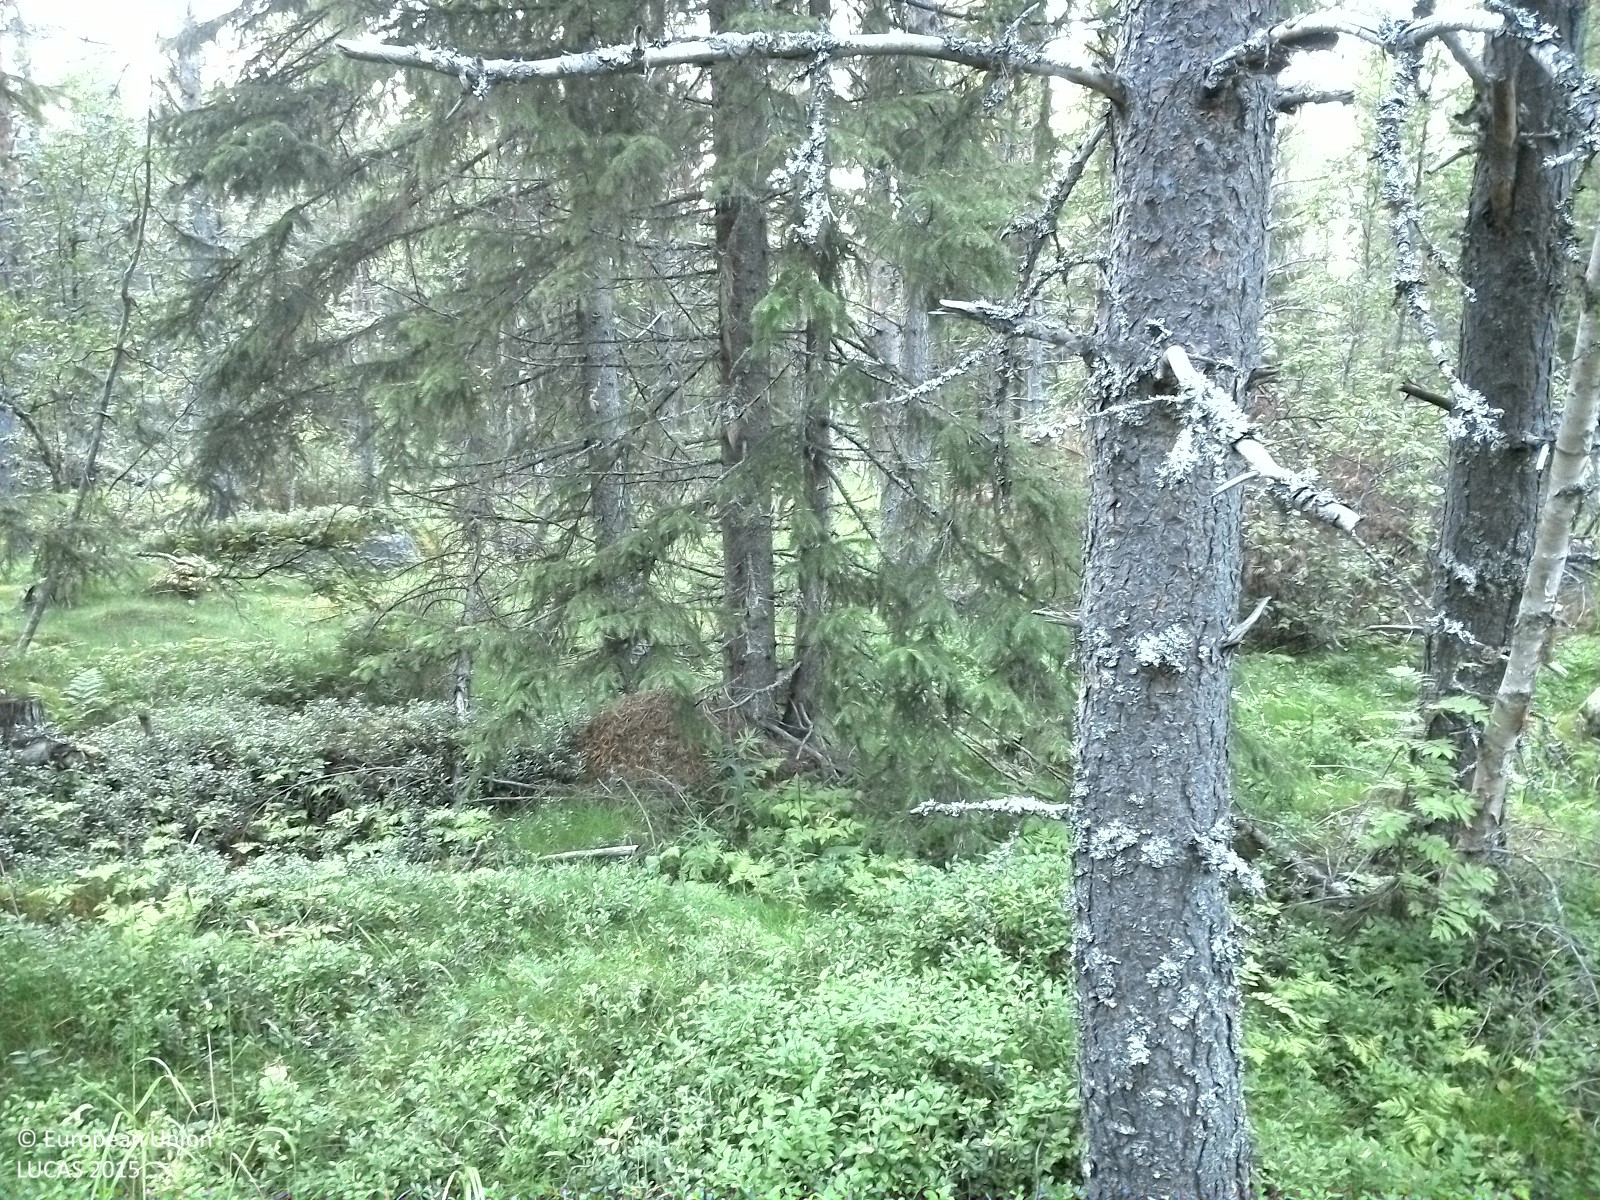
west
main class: Woodland
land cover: Other coniferous woodland
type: boreal forest
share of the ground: 25 - 50 %
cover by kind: coniferous forest trees 35 %, lichens and mosses 25 %, shrubs 20 %, herbaceous plants 20 %
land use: Forestry
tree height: > 5 m
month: August
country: SE
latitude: 62.3245
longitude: 16.1365
